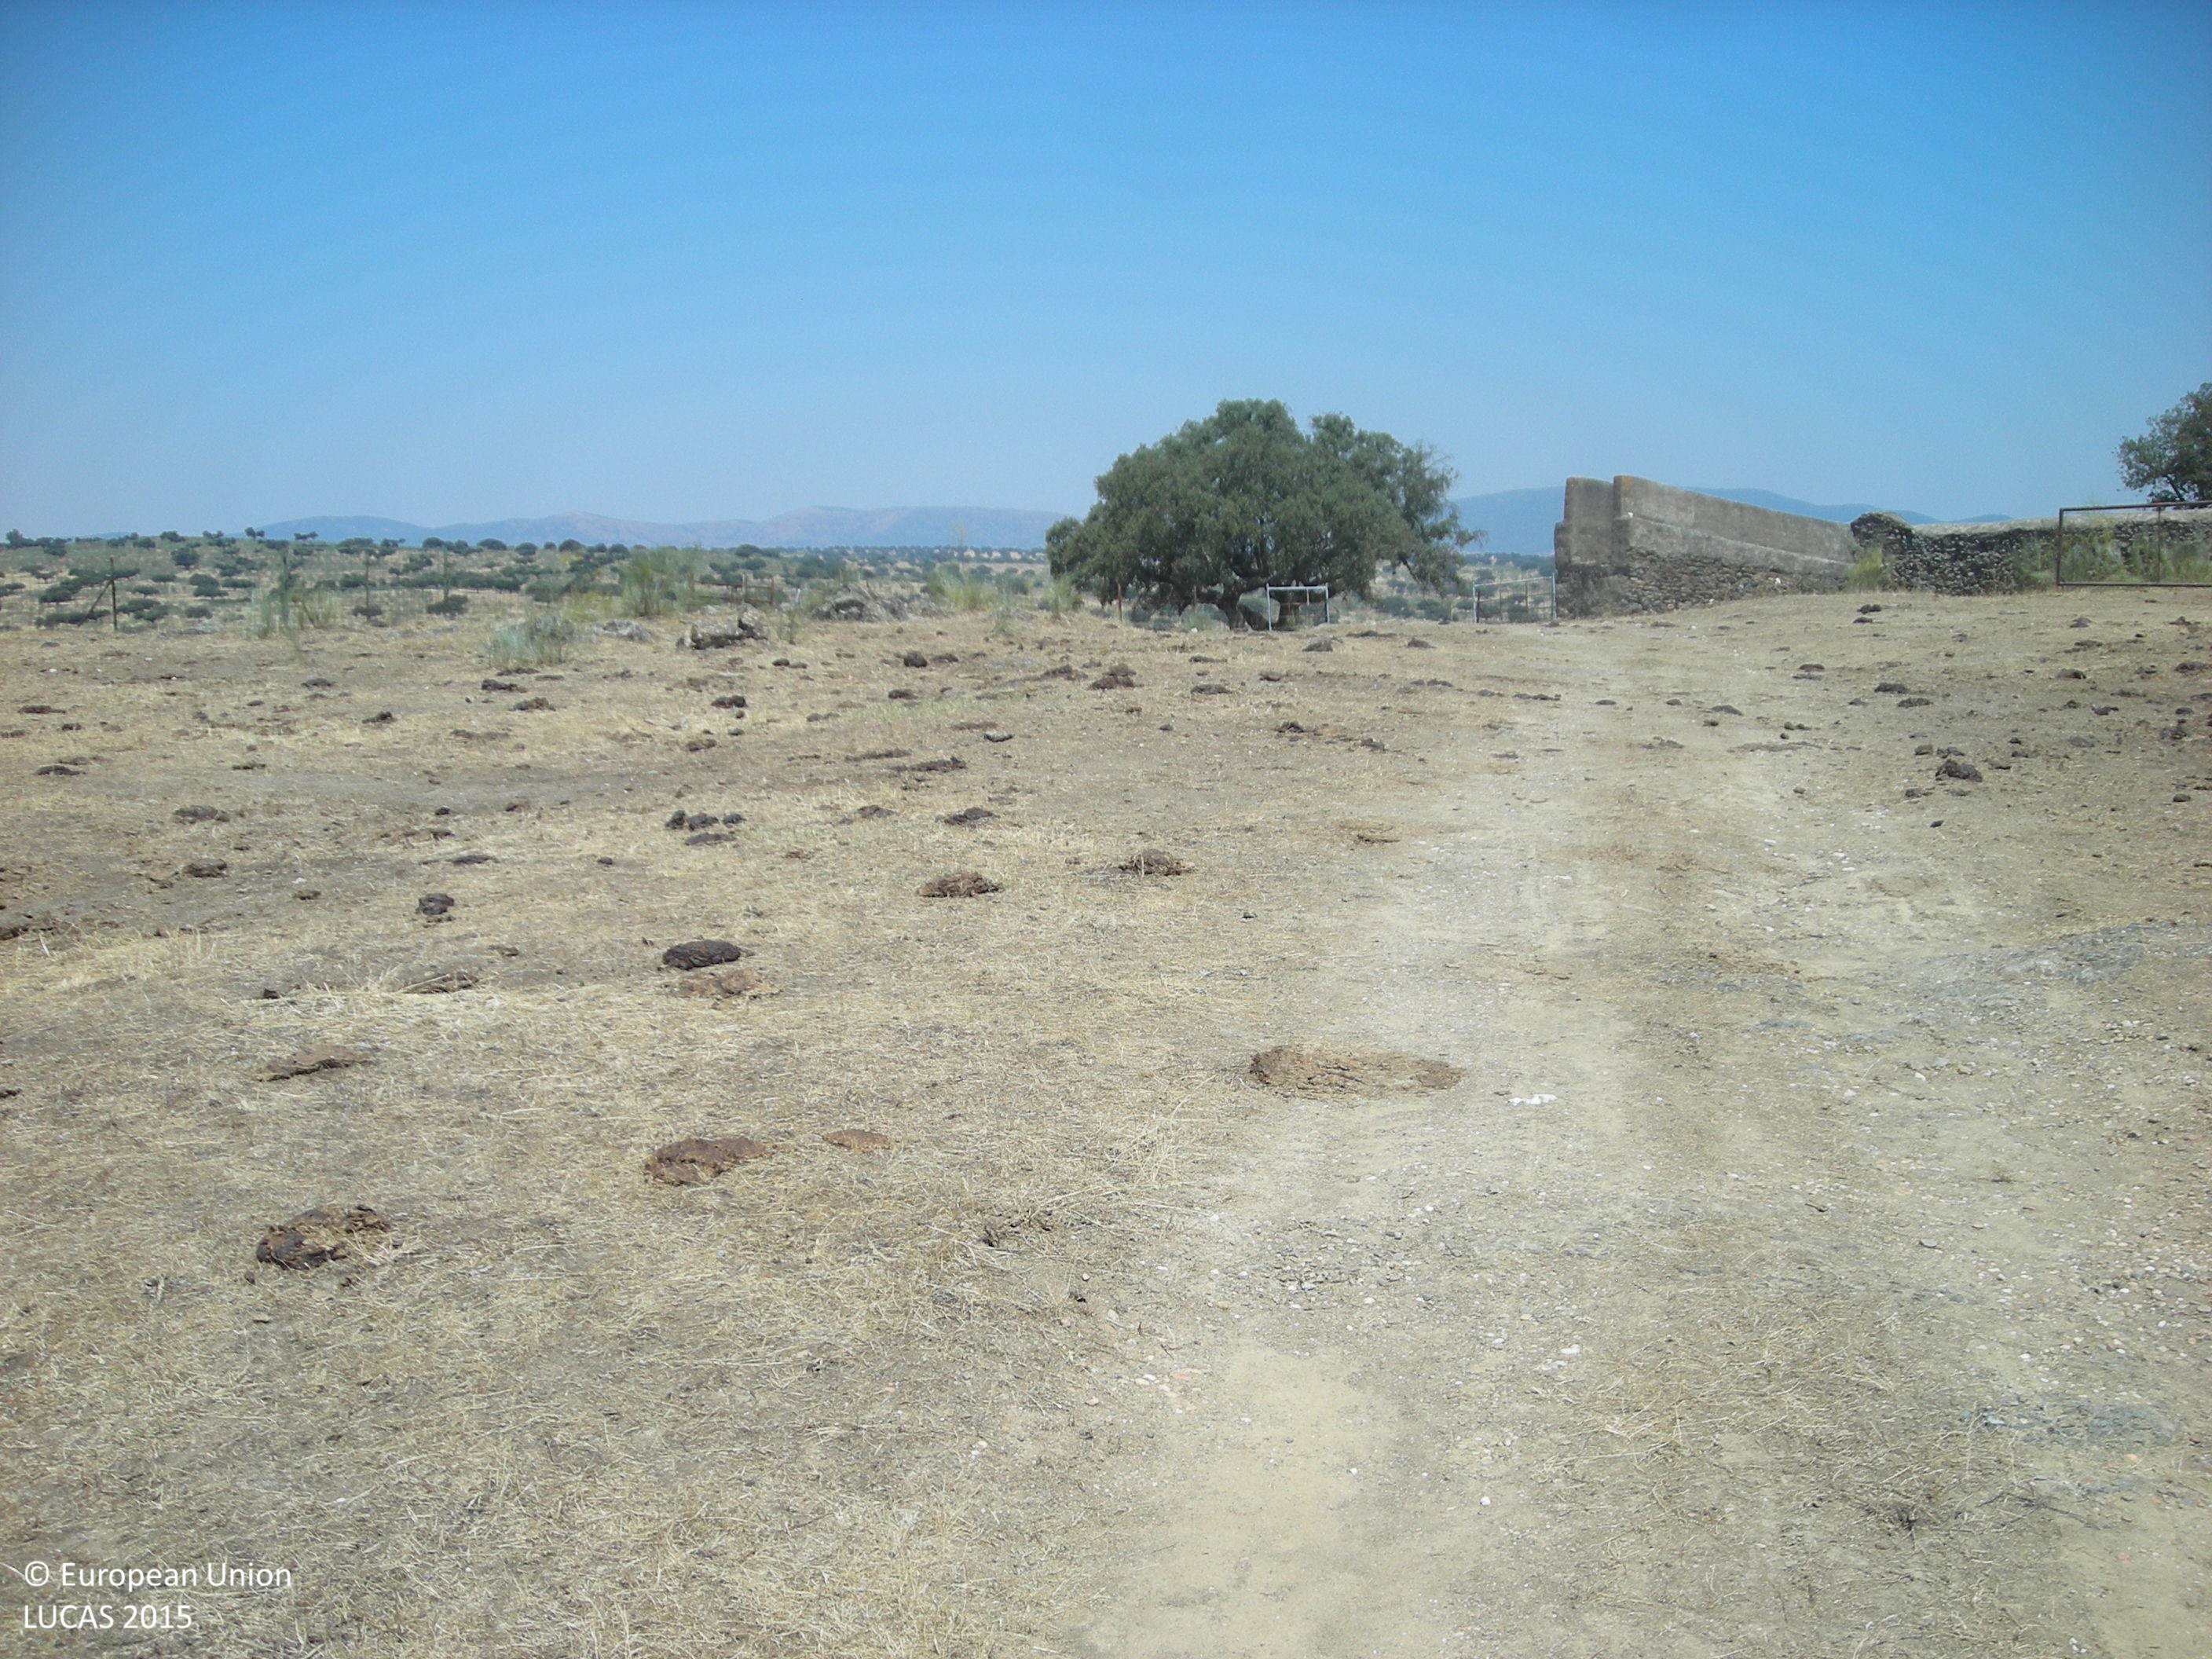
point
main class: Woodland
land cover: Broadleaved woodland
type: broadleaved evergreen forest
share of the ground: 25 - 50 %
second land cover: Grassland without tree/shrub cover
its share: 50 - 75 %
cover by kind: shrubs 60 %, broadleaved forest trees 40 %
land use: Forestry
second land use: Agriculture (excluding fallow land and kitchen gardens)
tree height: > 5 m
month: June
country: ES
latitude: 39.2451
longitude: -5.5164
